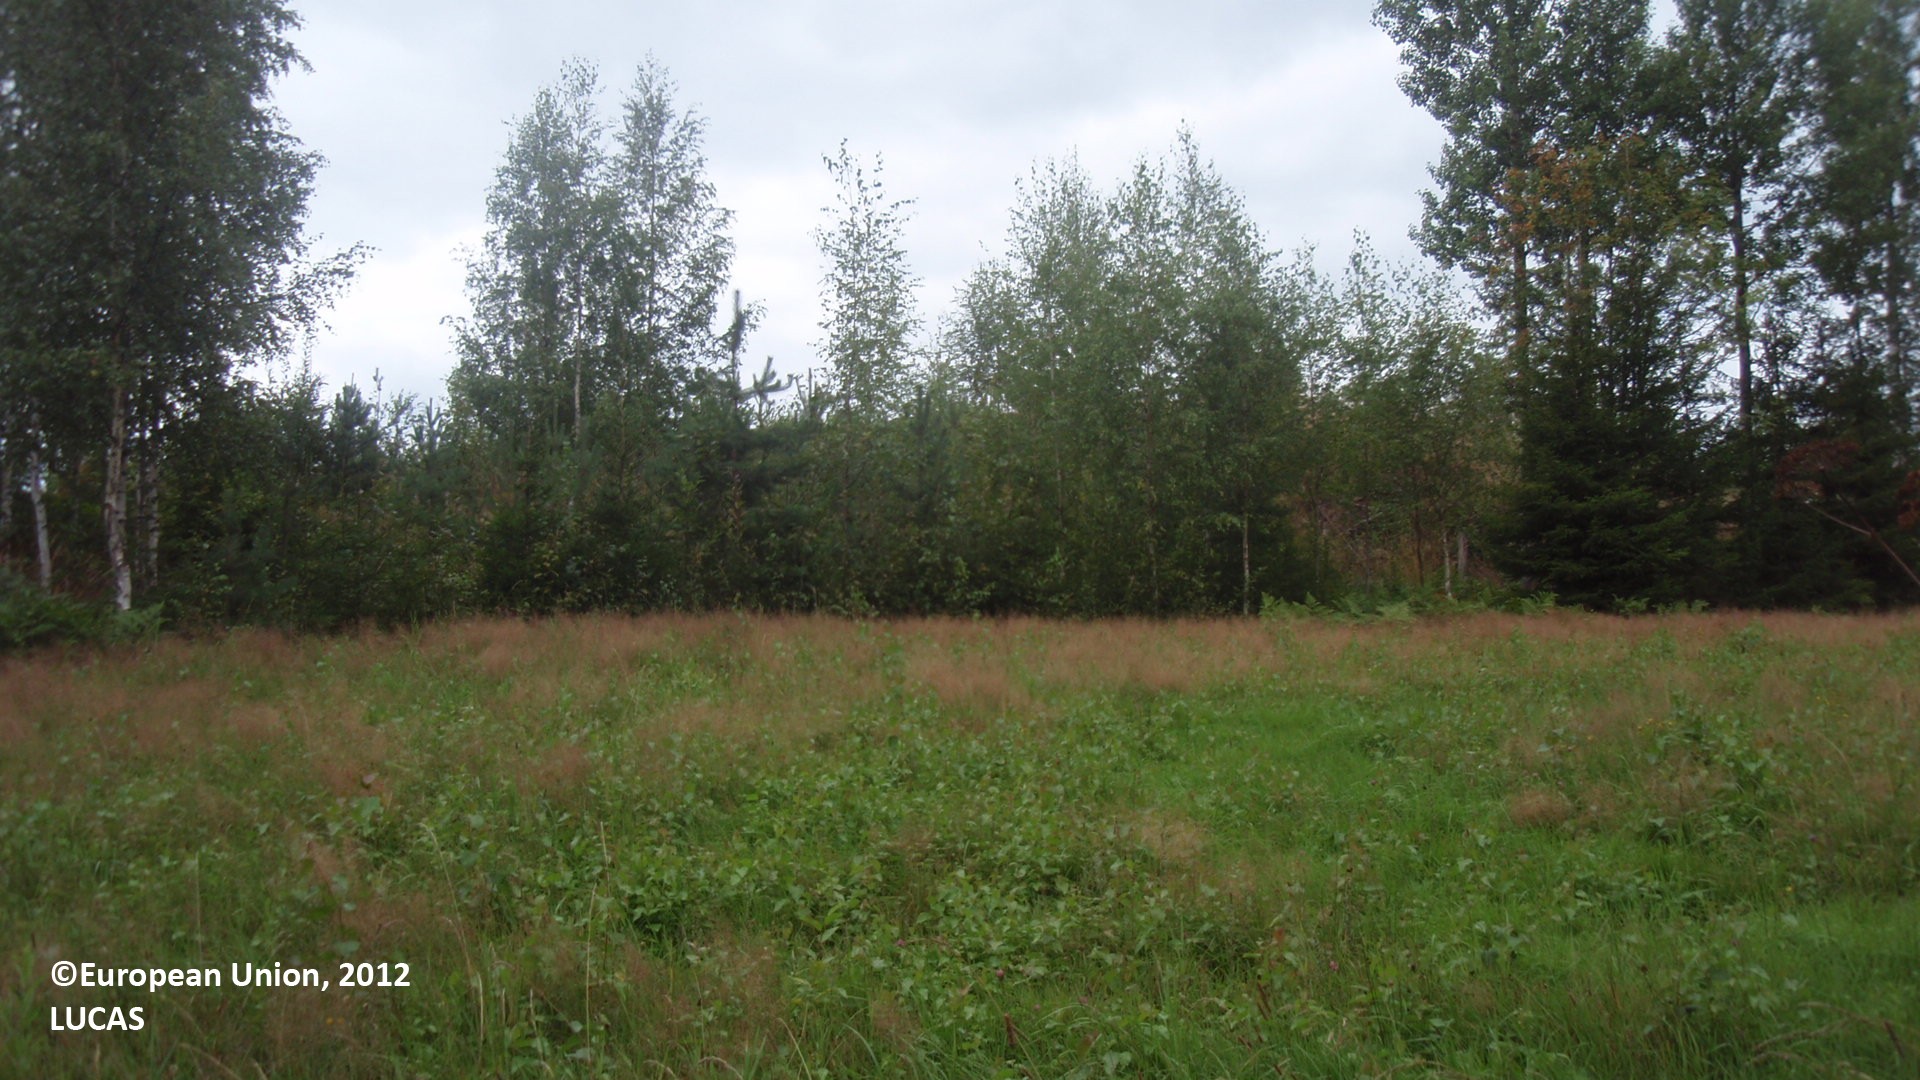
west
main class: Shrubland
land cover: Shrubland with sparse tree cover
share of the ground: > 75 %
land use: Agriculture (excluding fallow land and kitchen gardens)
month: August
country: FI
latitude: 60.8811
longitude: 27.4048
